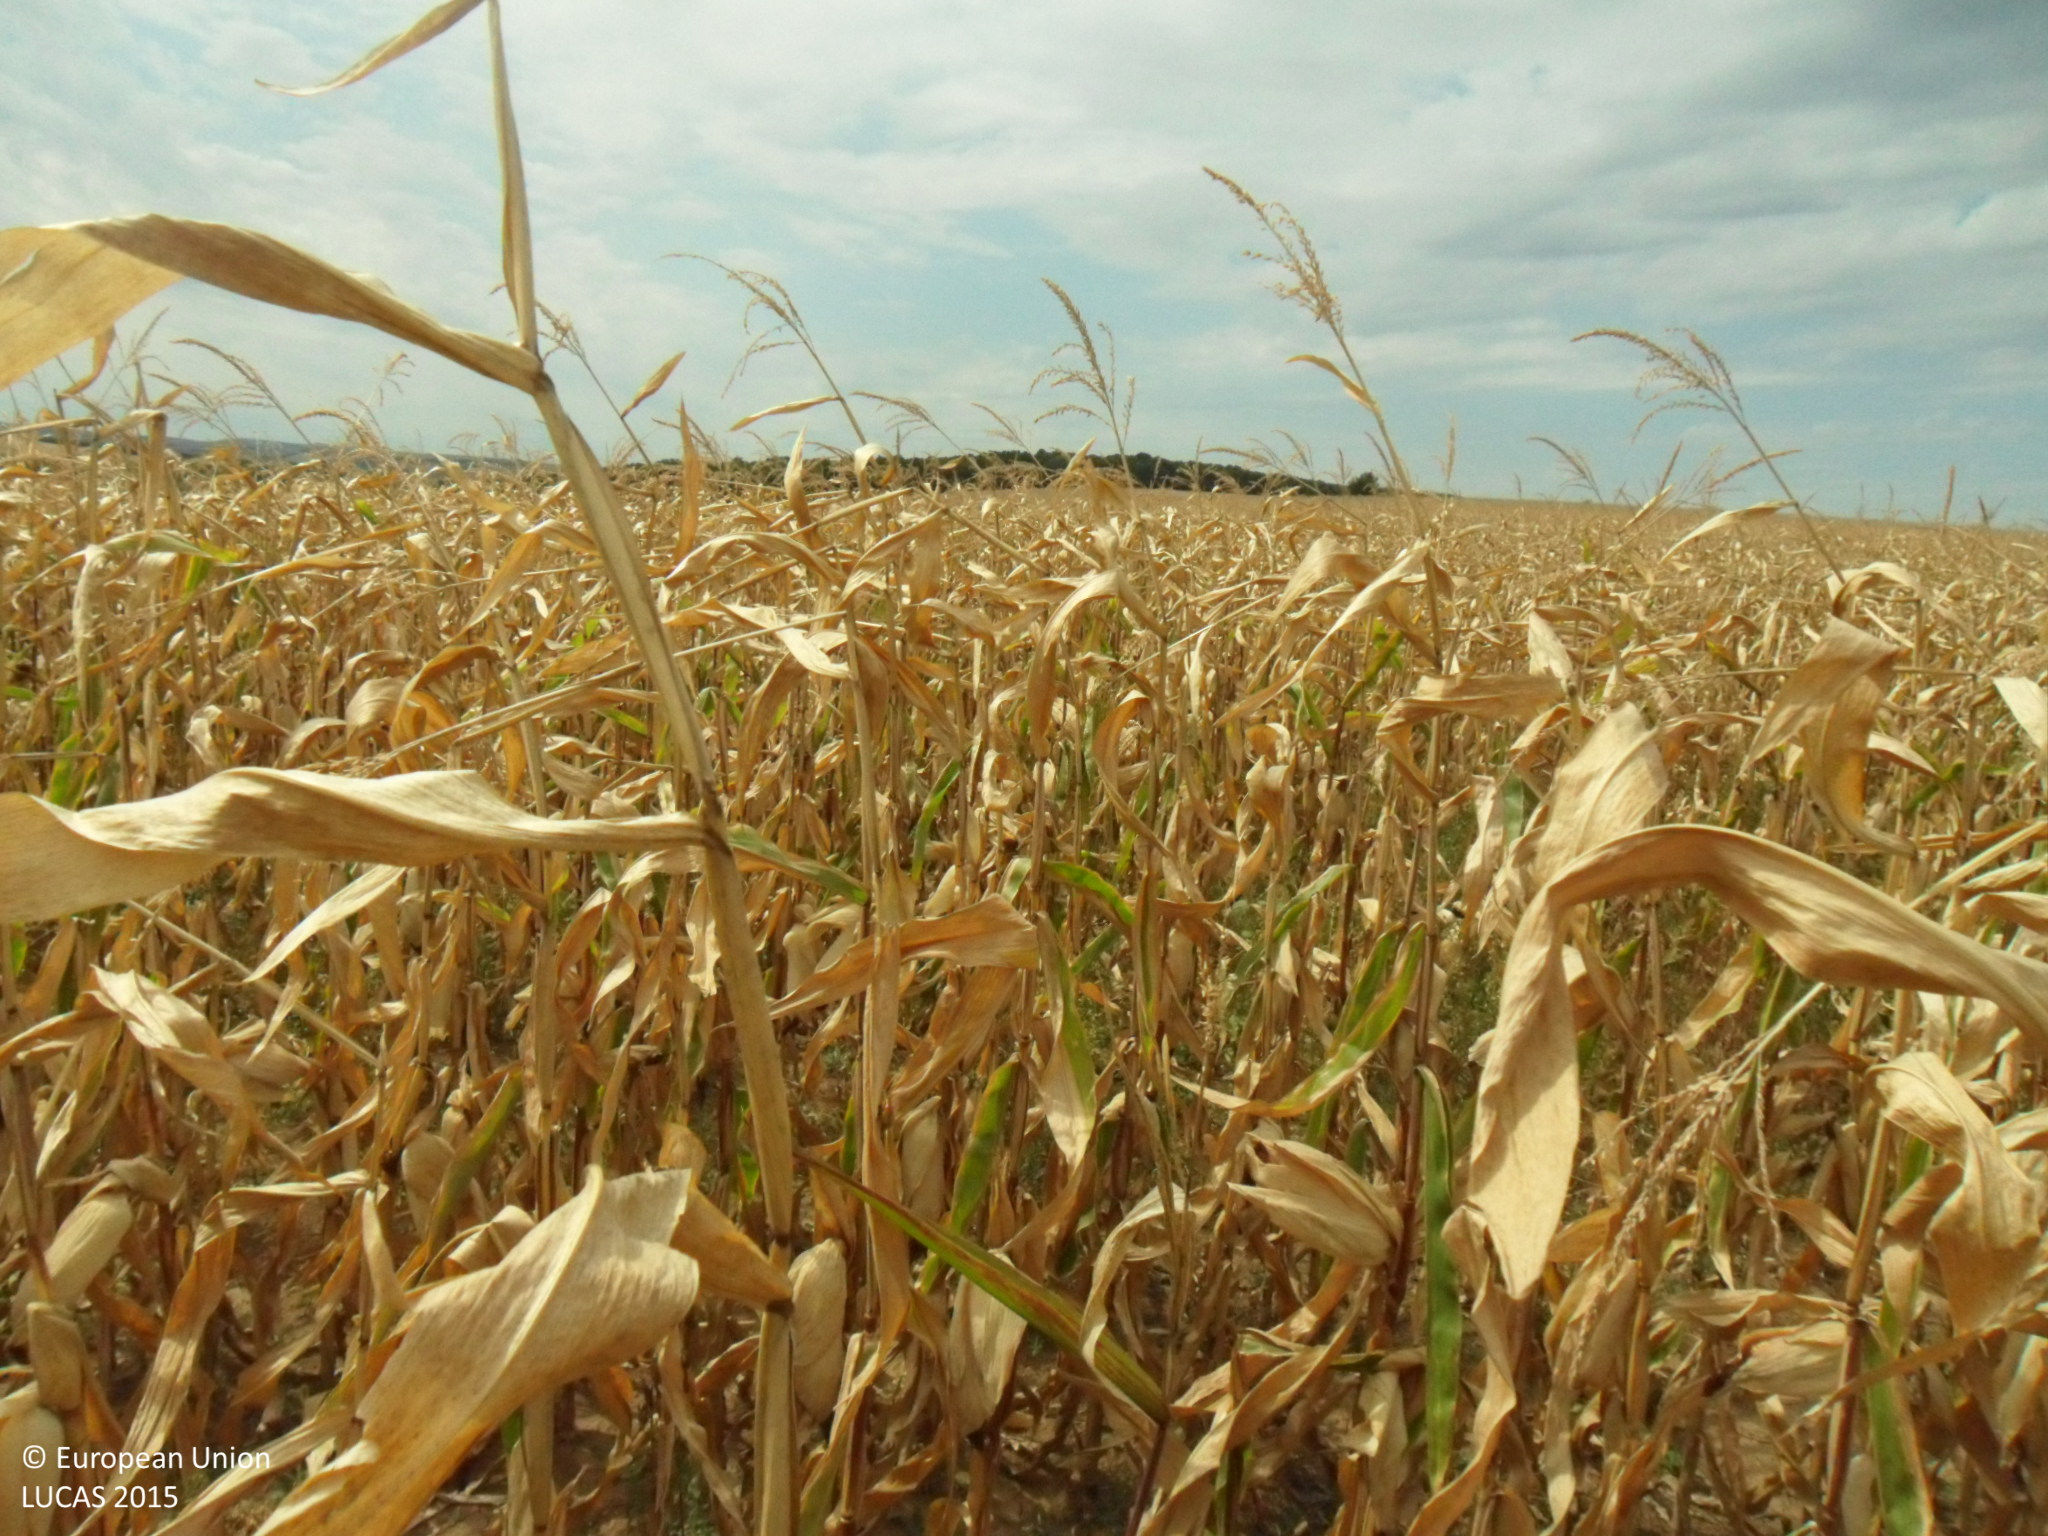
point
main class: Cropland
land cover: Maize
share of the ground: > 75 %
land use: Agriculture (excluding fallow land and kitchen gardens)
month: September
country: BG
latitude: 43.5255
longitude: 26.3211
